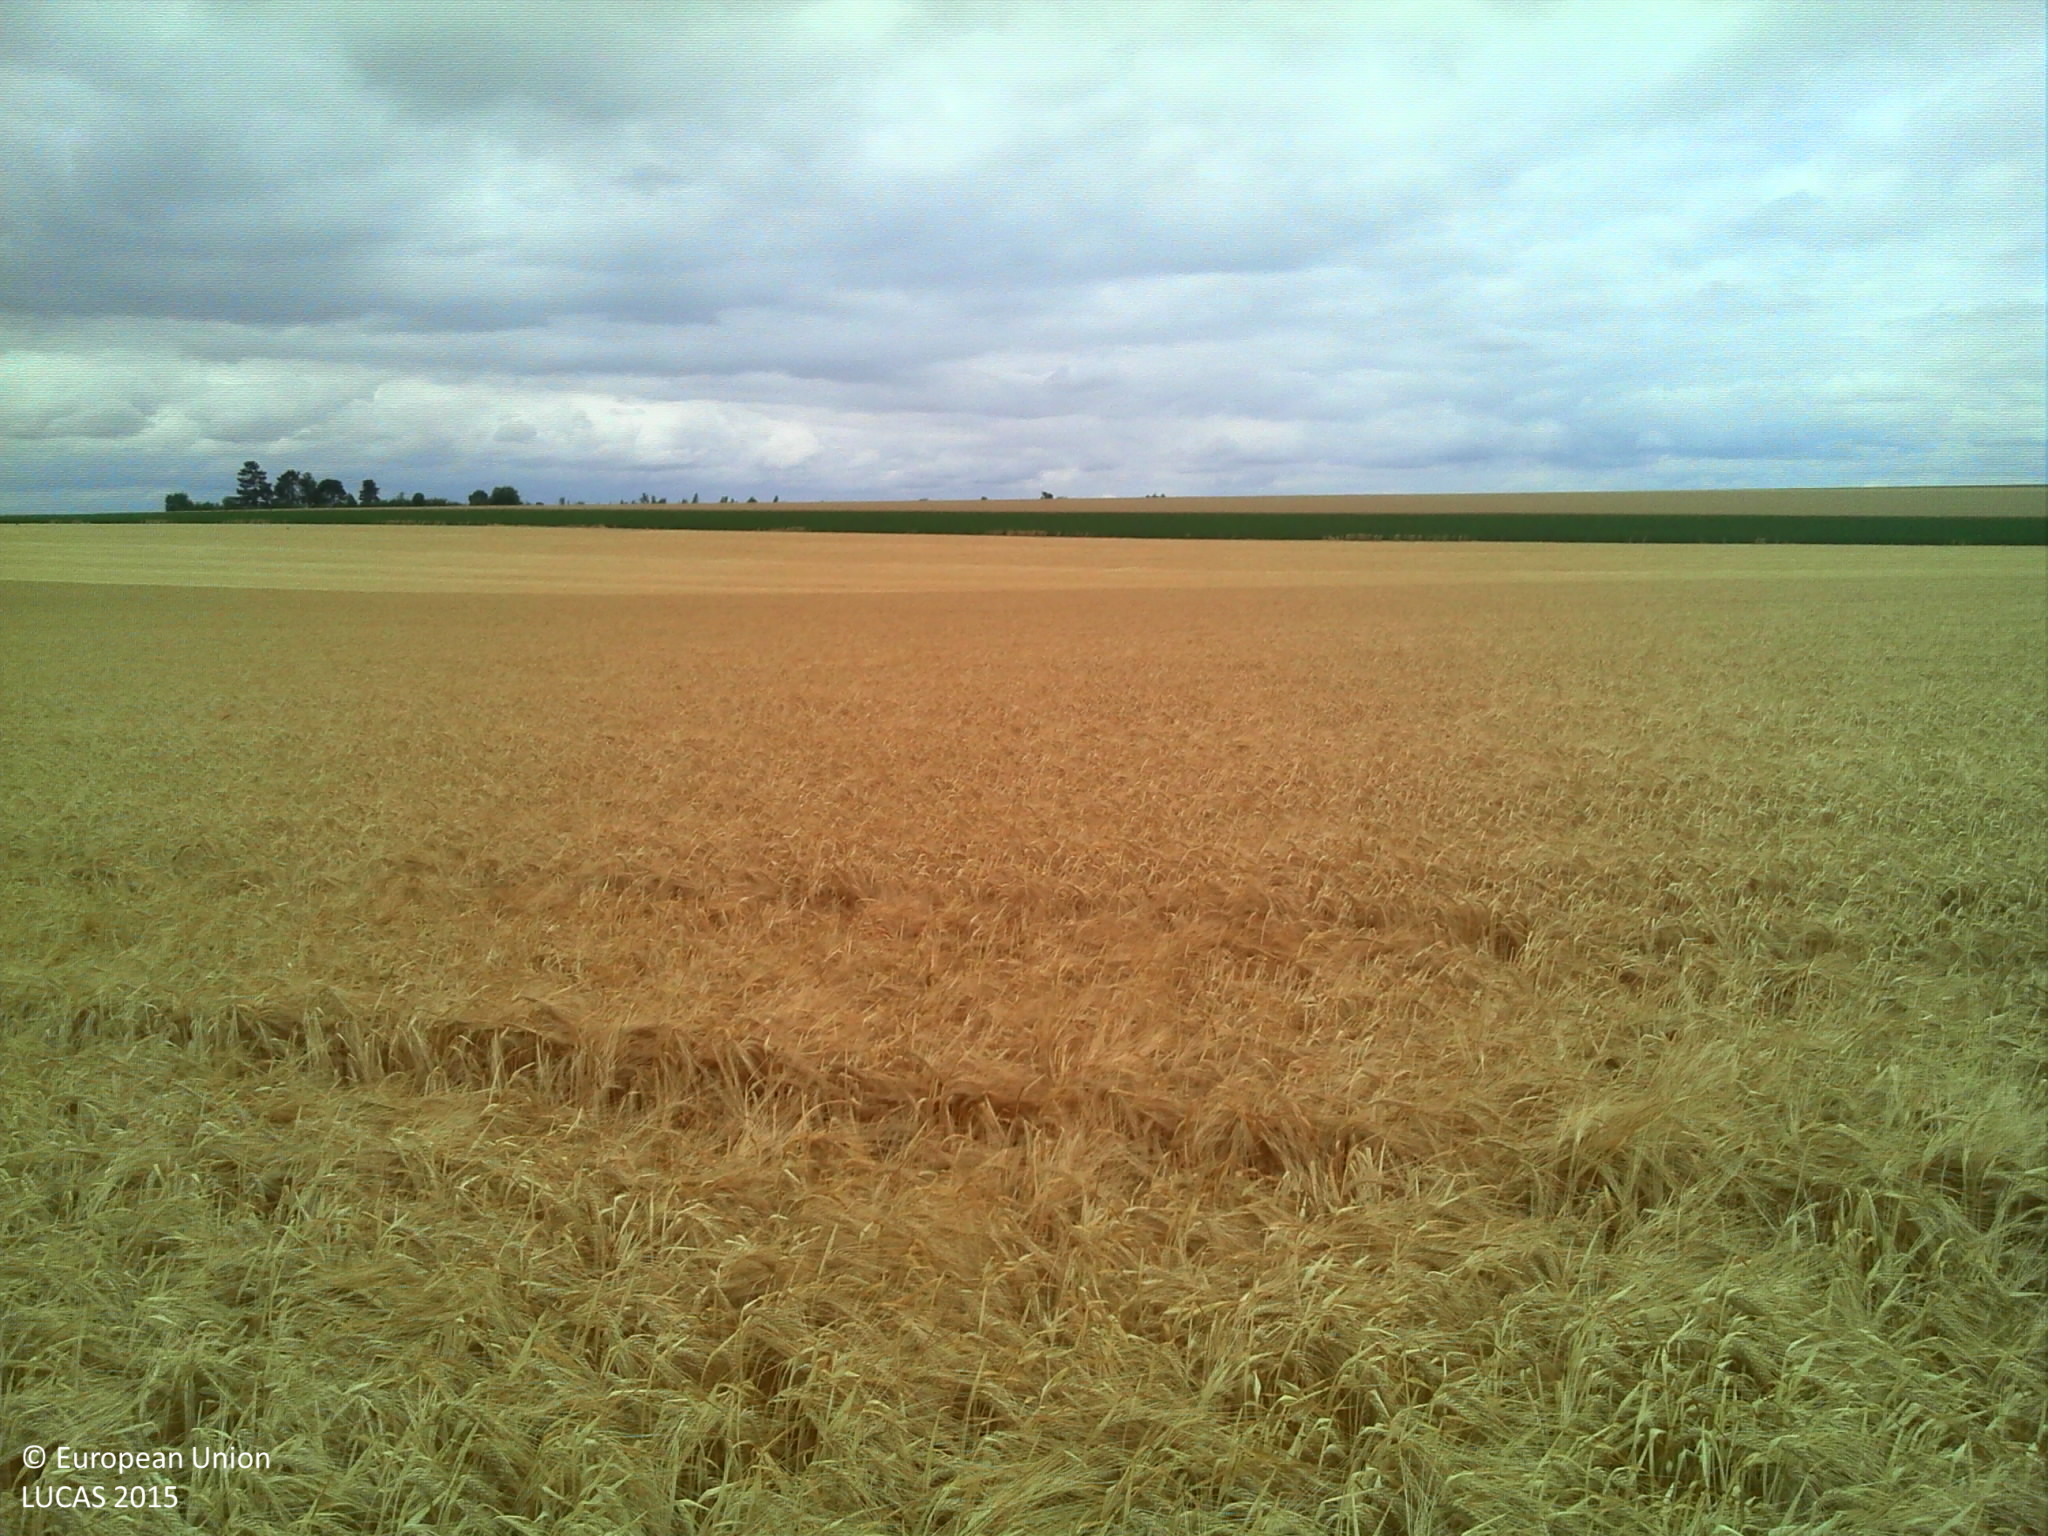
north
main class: Cropland
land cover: Barley
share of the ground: > 75 %
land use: Agriculture (excluding fallow land and kitchen gardens)
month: July
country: FR
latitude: 48.7571
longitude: 4.2149
